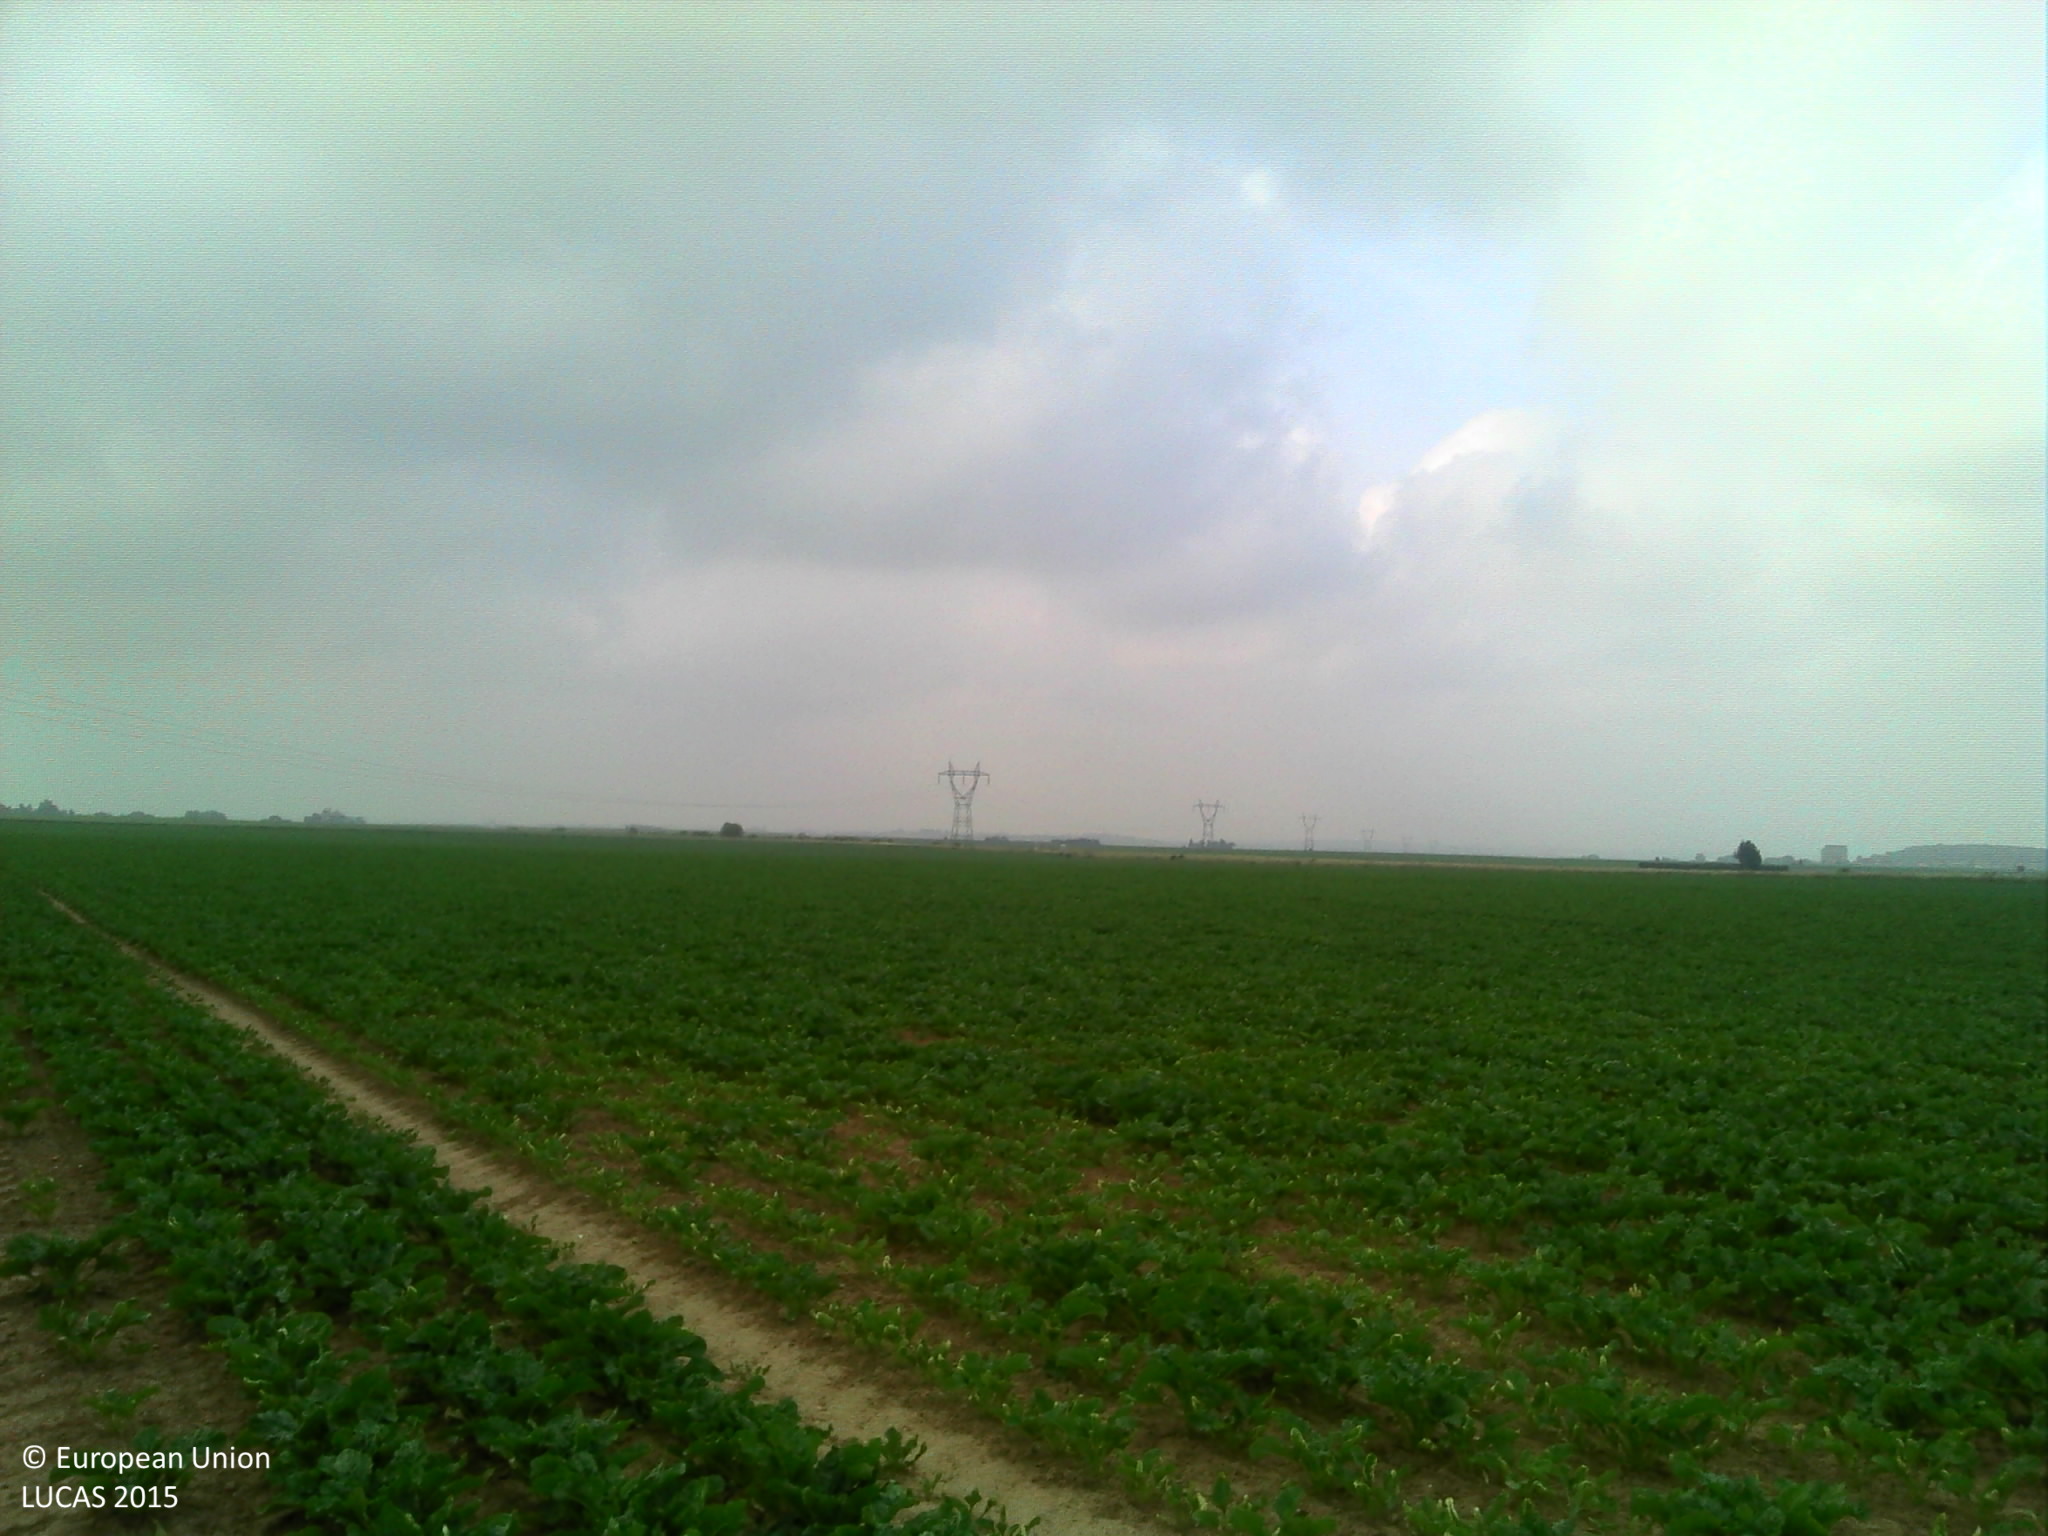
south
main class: Cropland
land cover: Sugar beet
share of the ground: > 75 %
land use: Agriculture (excluding fallow land and kitchen gardens)
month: June
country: FR
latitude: 49.5459
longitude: 2.5942
